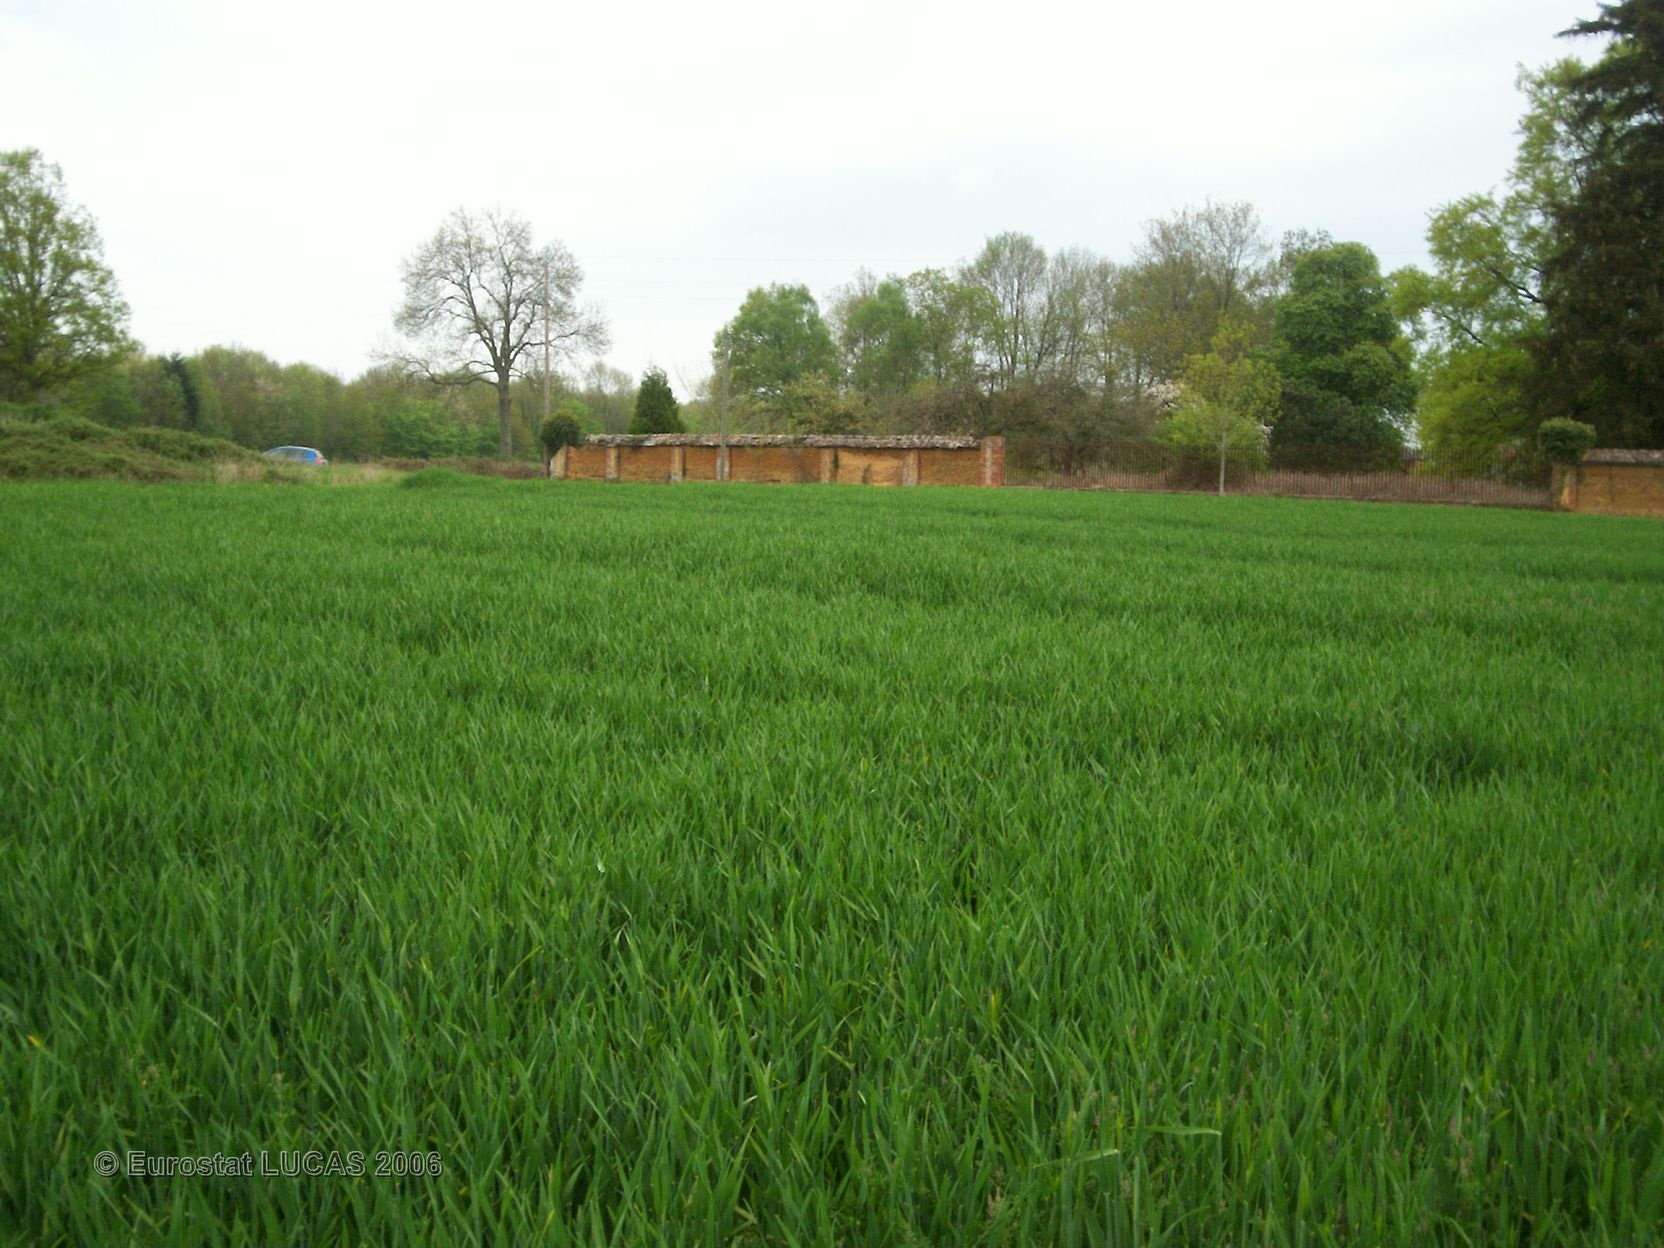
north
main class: Cropland
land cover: Barley
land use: Agriculture (excluding fallow land and kitchen gardens)
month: May
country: FR
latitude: 48.9080
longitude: 0.6020
